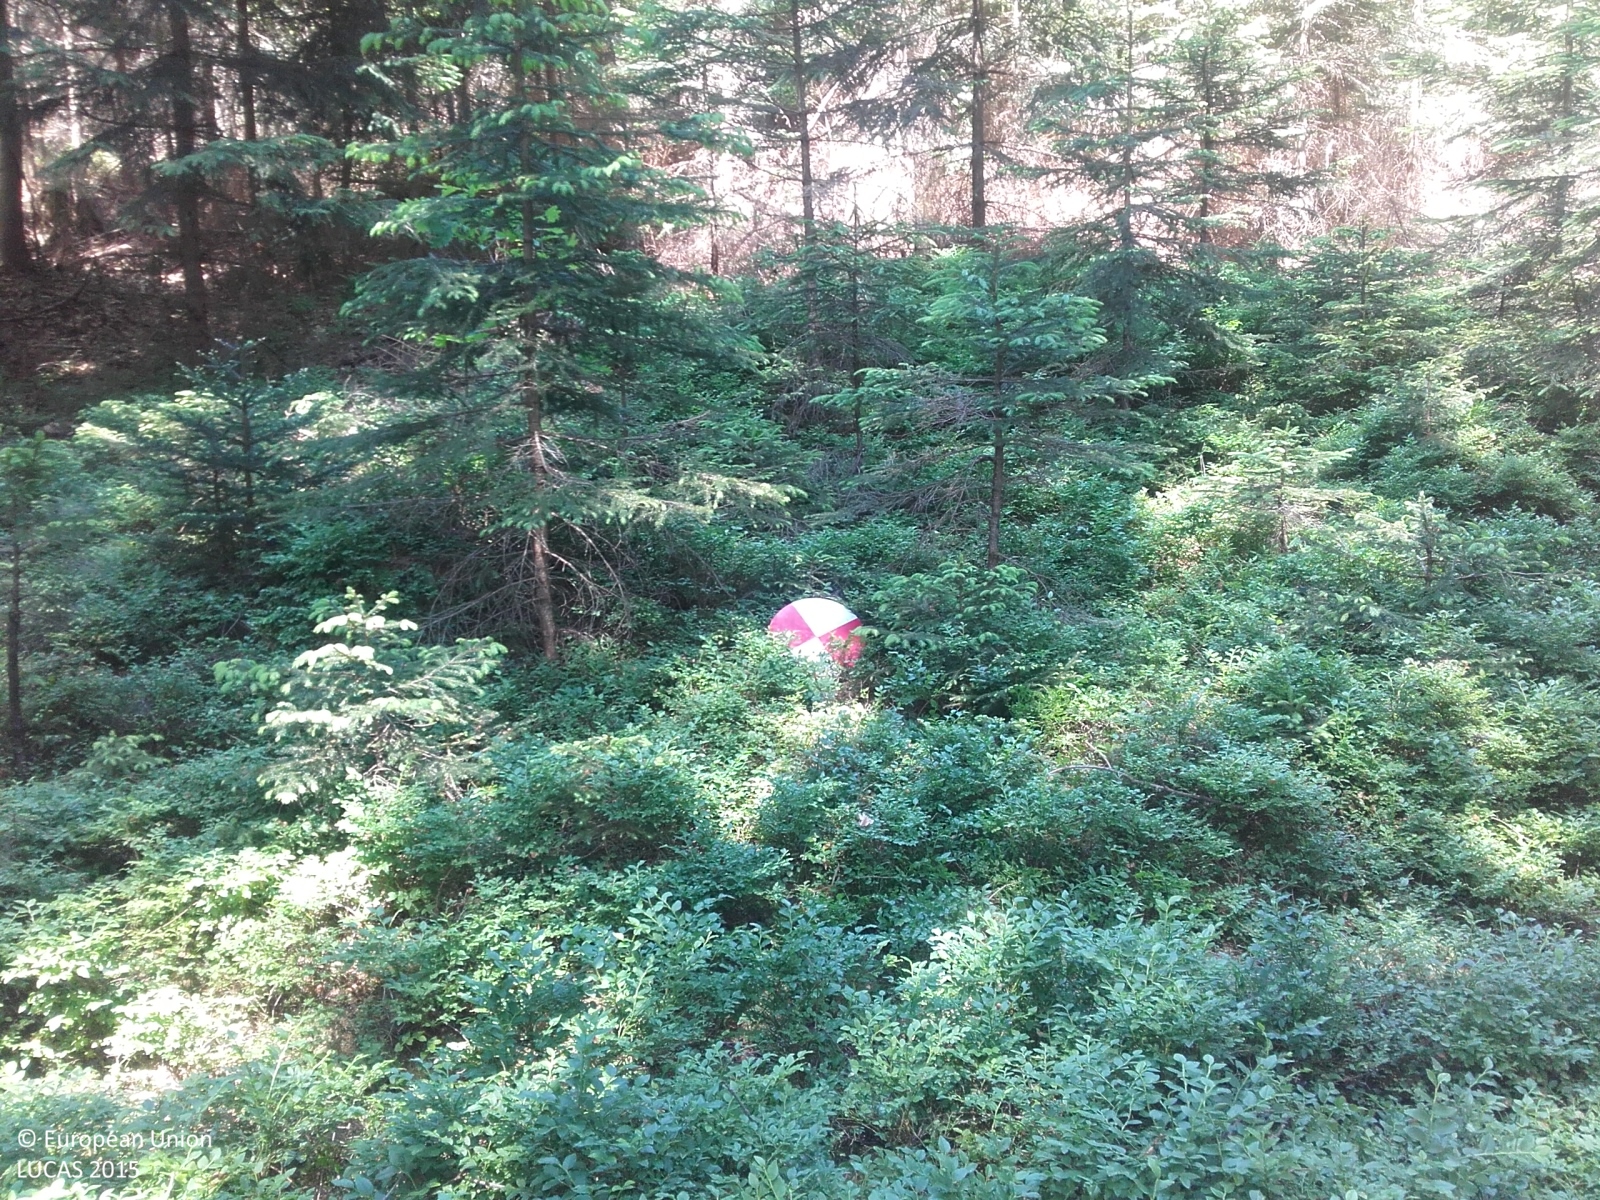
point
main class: Woodland
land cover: Spruce dominated coniferous woodland
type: hemiboreal forest and nemoral coniferous forest and mixed broadleaved-coniferous forest
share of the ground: > 75 %
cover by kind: coniferous forest trees 95 %, herbaceous plants 5 %
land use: Forestry
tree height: > 5 m
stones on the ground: < 10 %
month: June
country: CZ
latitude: 49.5049
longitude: 18.7339
